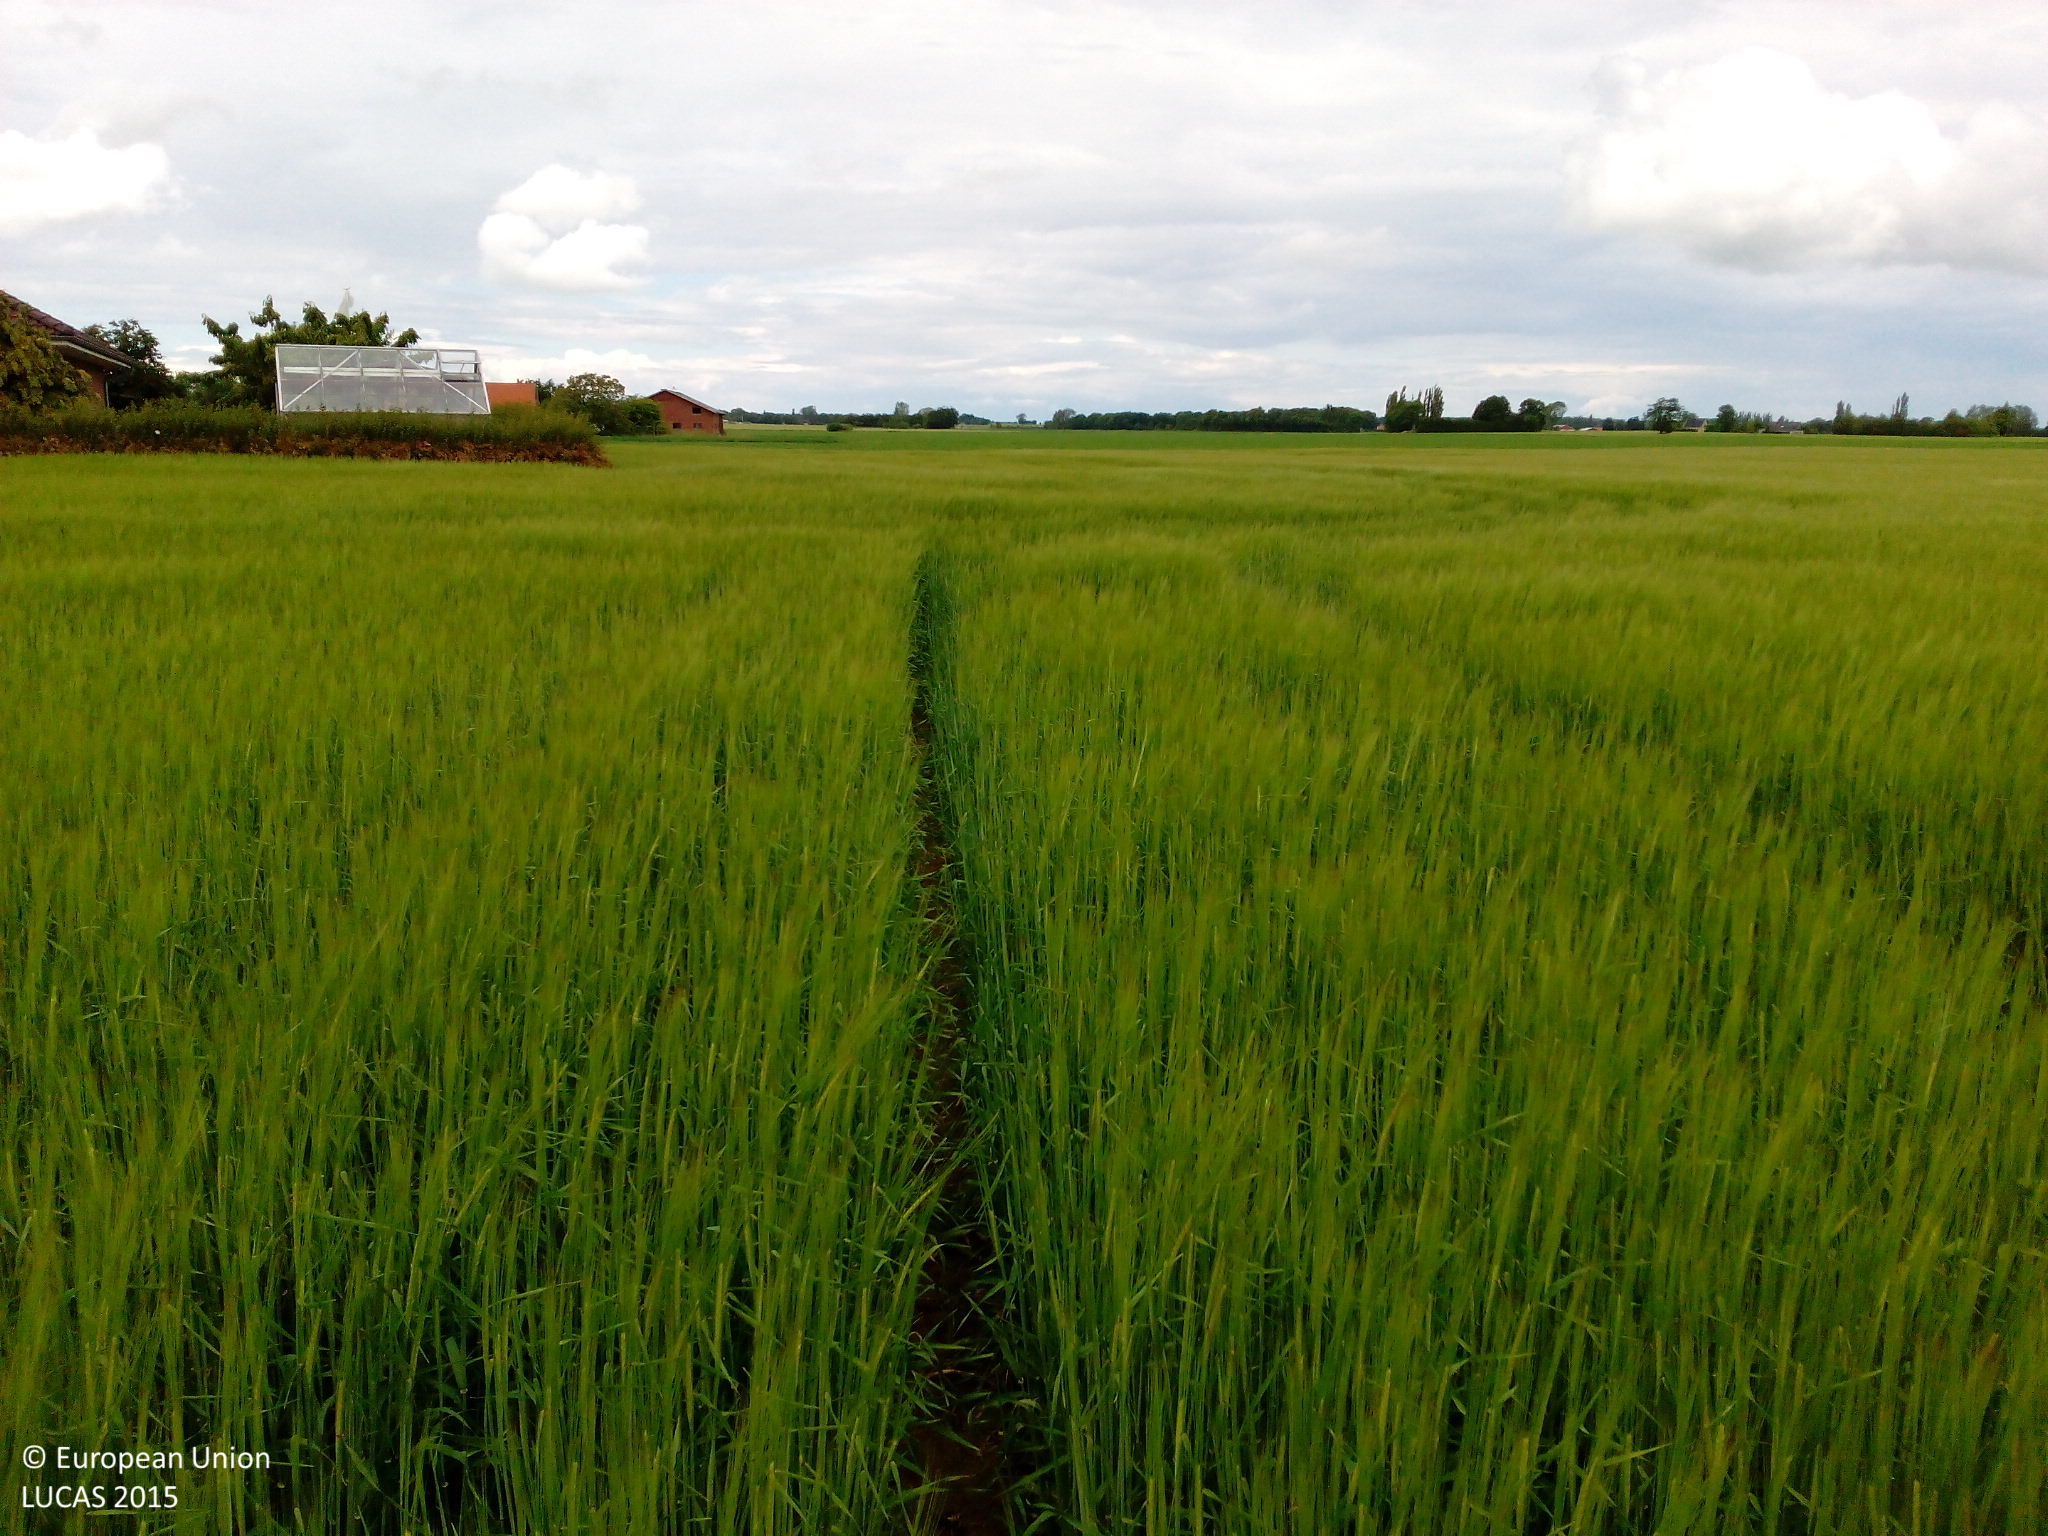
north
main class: Cropland
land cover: Barley
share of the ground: > 75 %
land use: Agriculture (excluding fallow land and kitchen gardens)
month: June
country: DK
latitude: 54.8876
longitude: 11.2307
